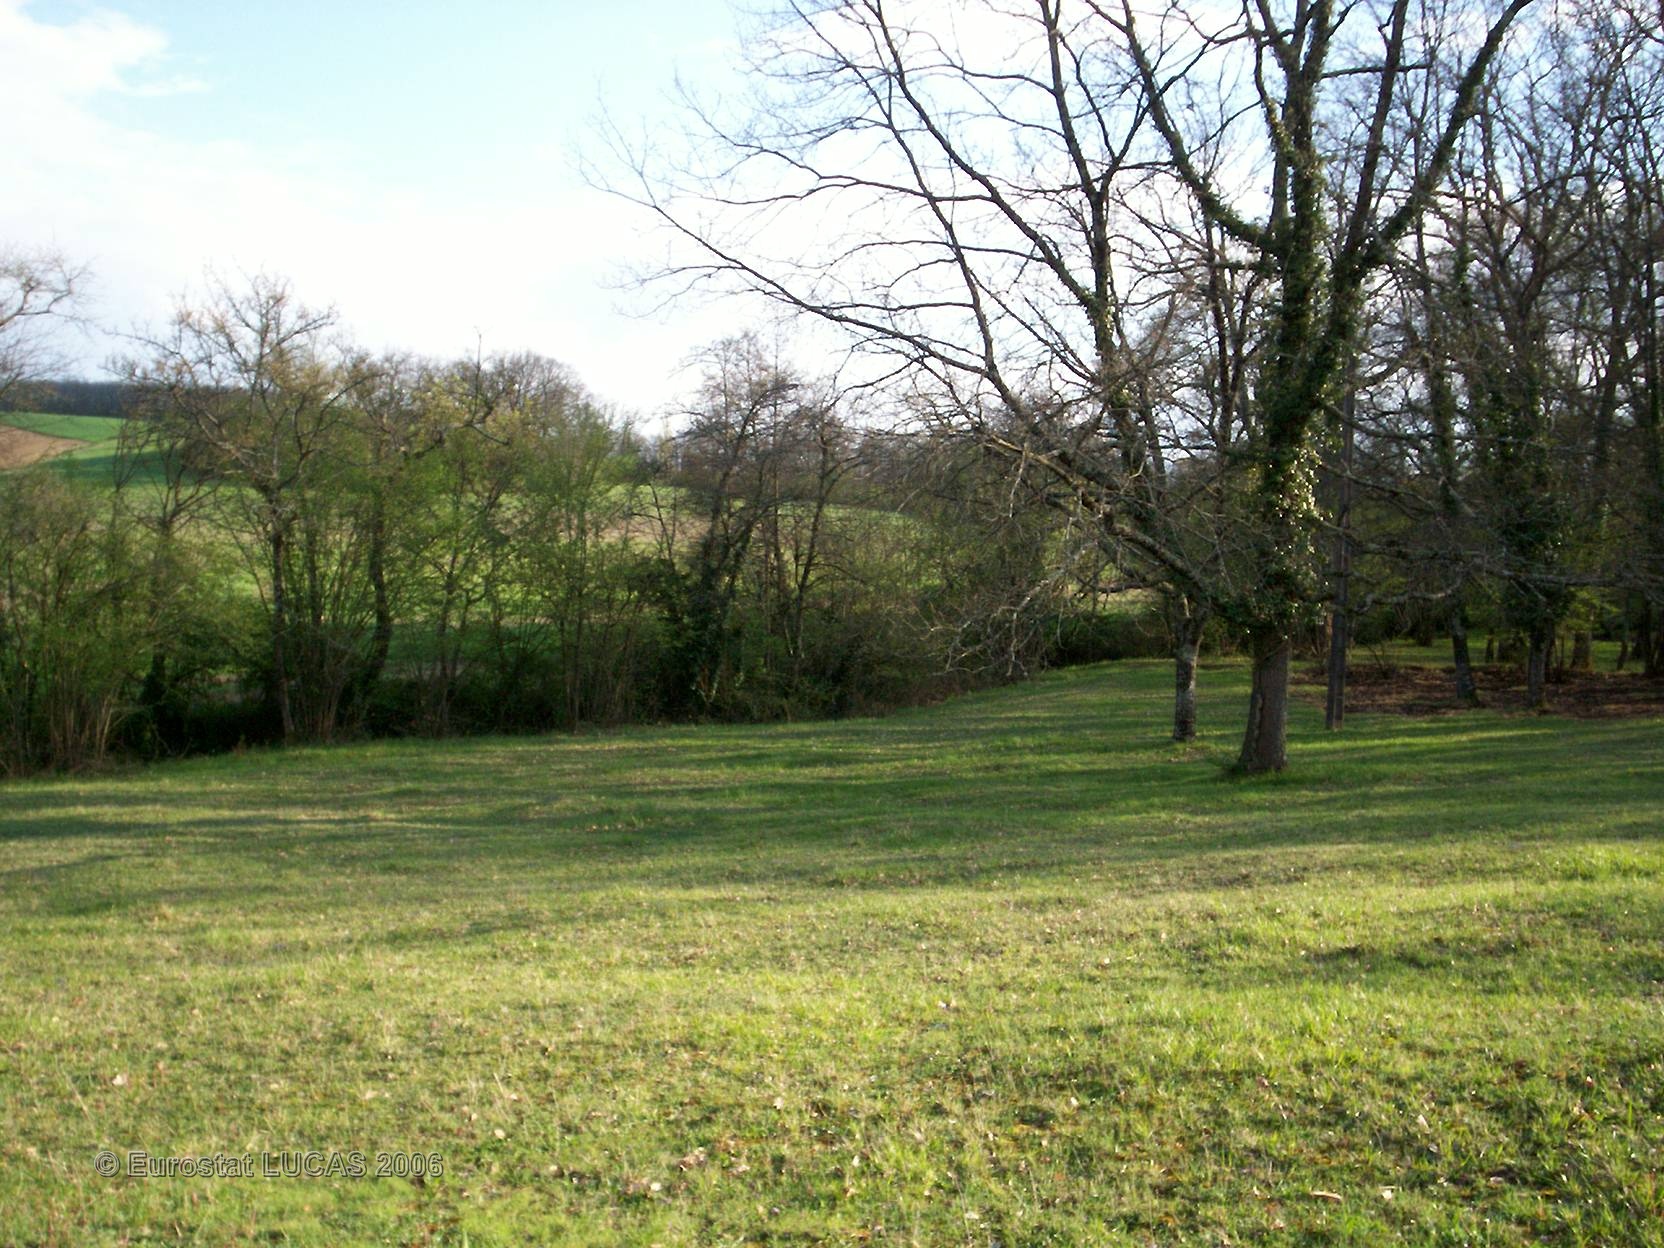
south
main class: Grassland
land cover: Grassland without tree/shrub cover
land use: Agriculture (excluding fallow land and kitchen gardens)
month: April
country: FR
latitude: 43.9616
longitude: 0.2350
